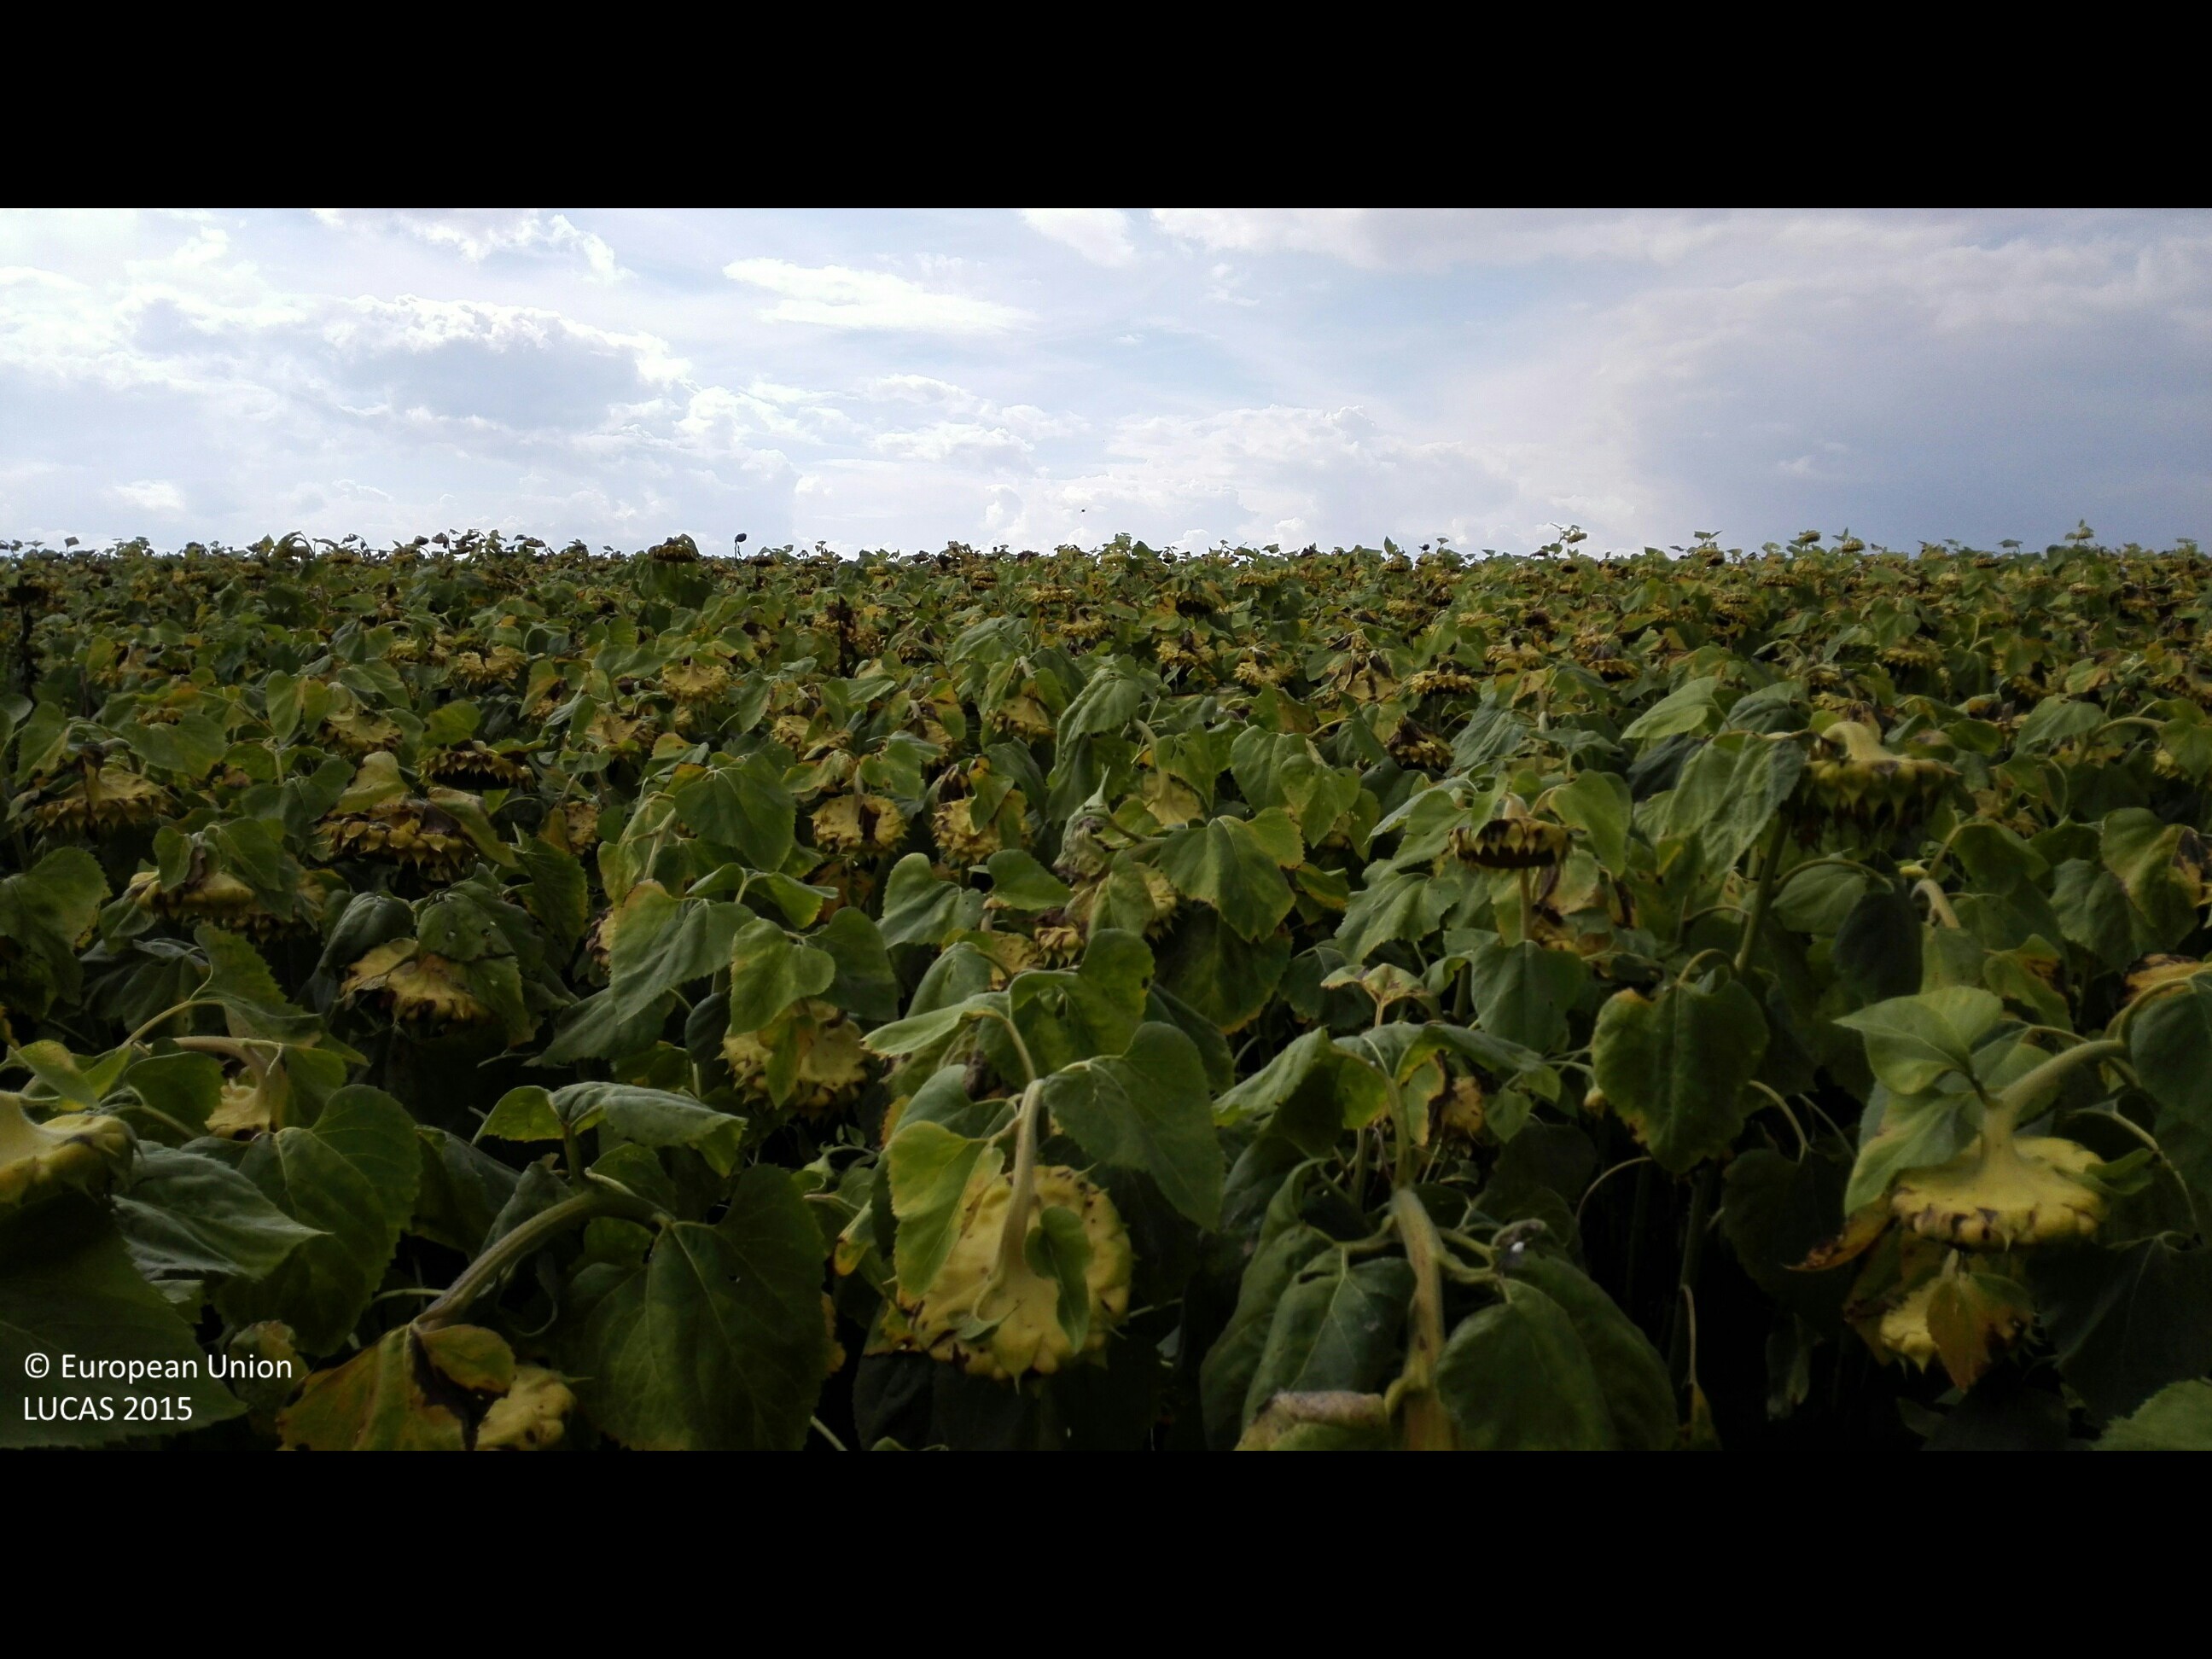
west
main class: Cropland
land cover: Sunflower
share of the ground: > 75 %
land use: Agriculture (excluding fallow land and kitchen gardens)
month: August
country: HU
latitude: 47.3160
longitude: 21.6190
